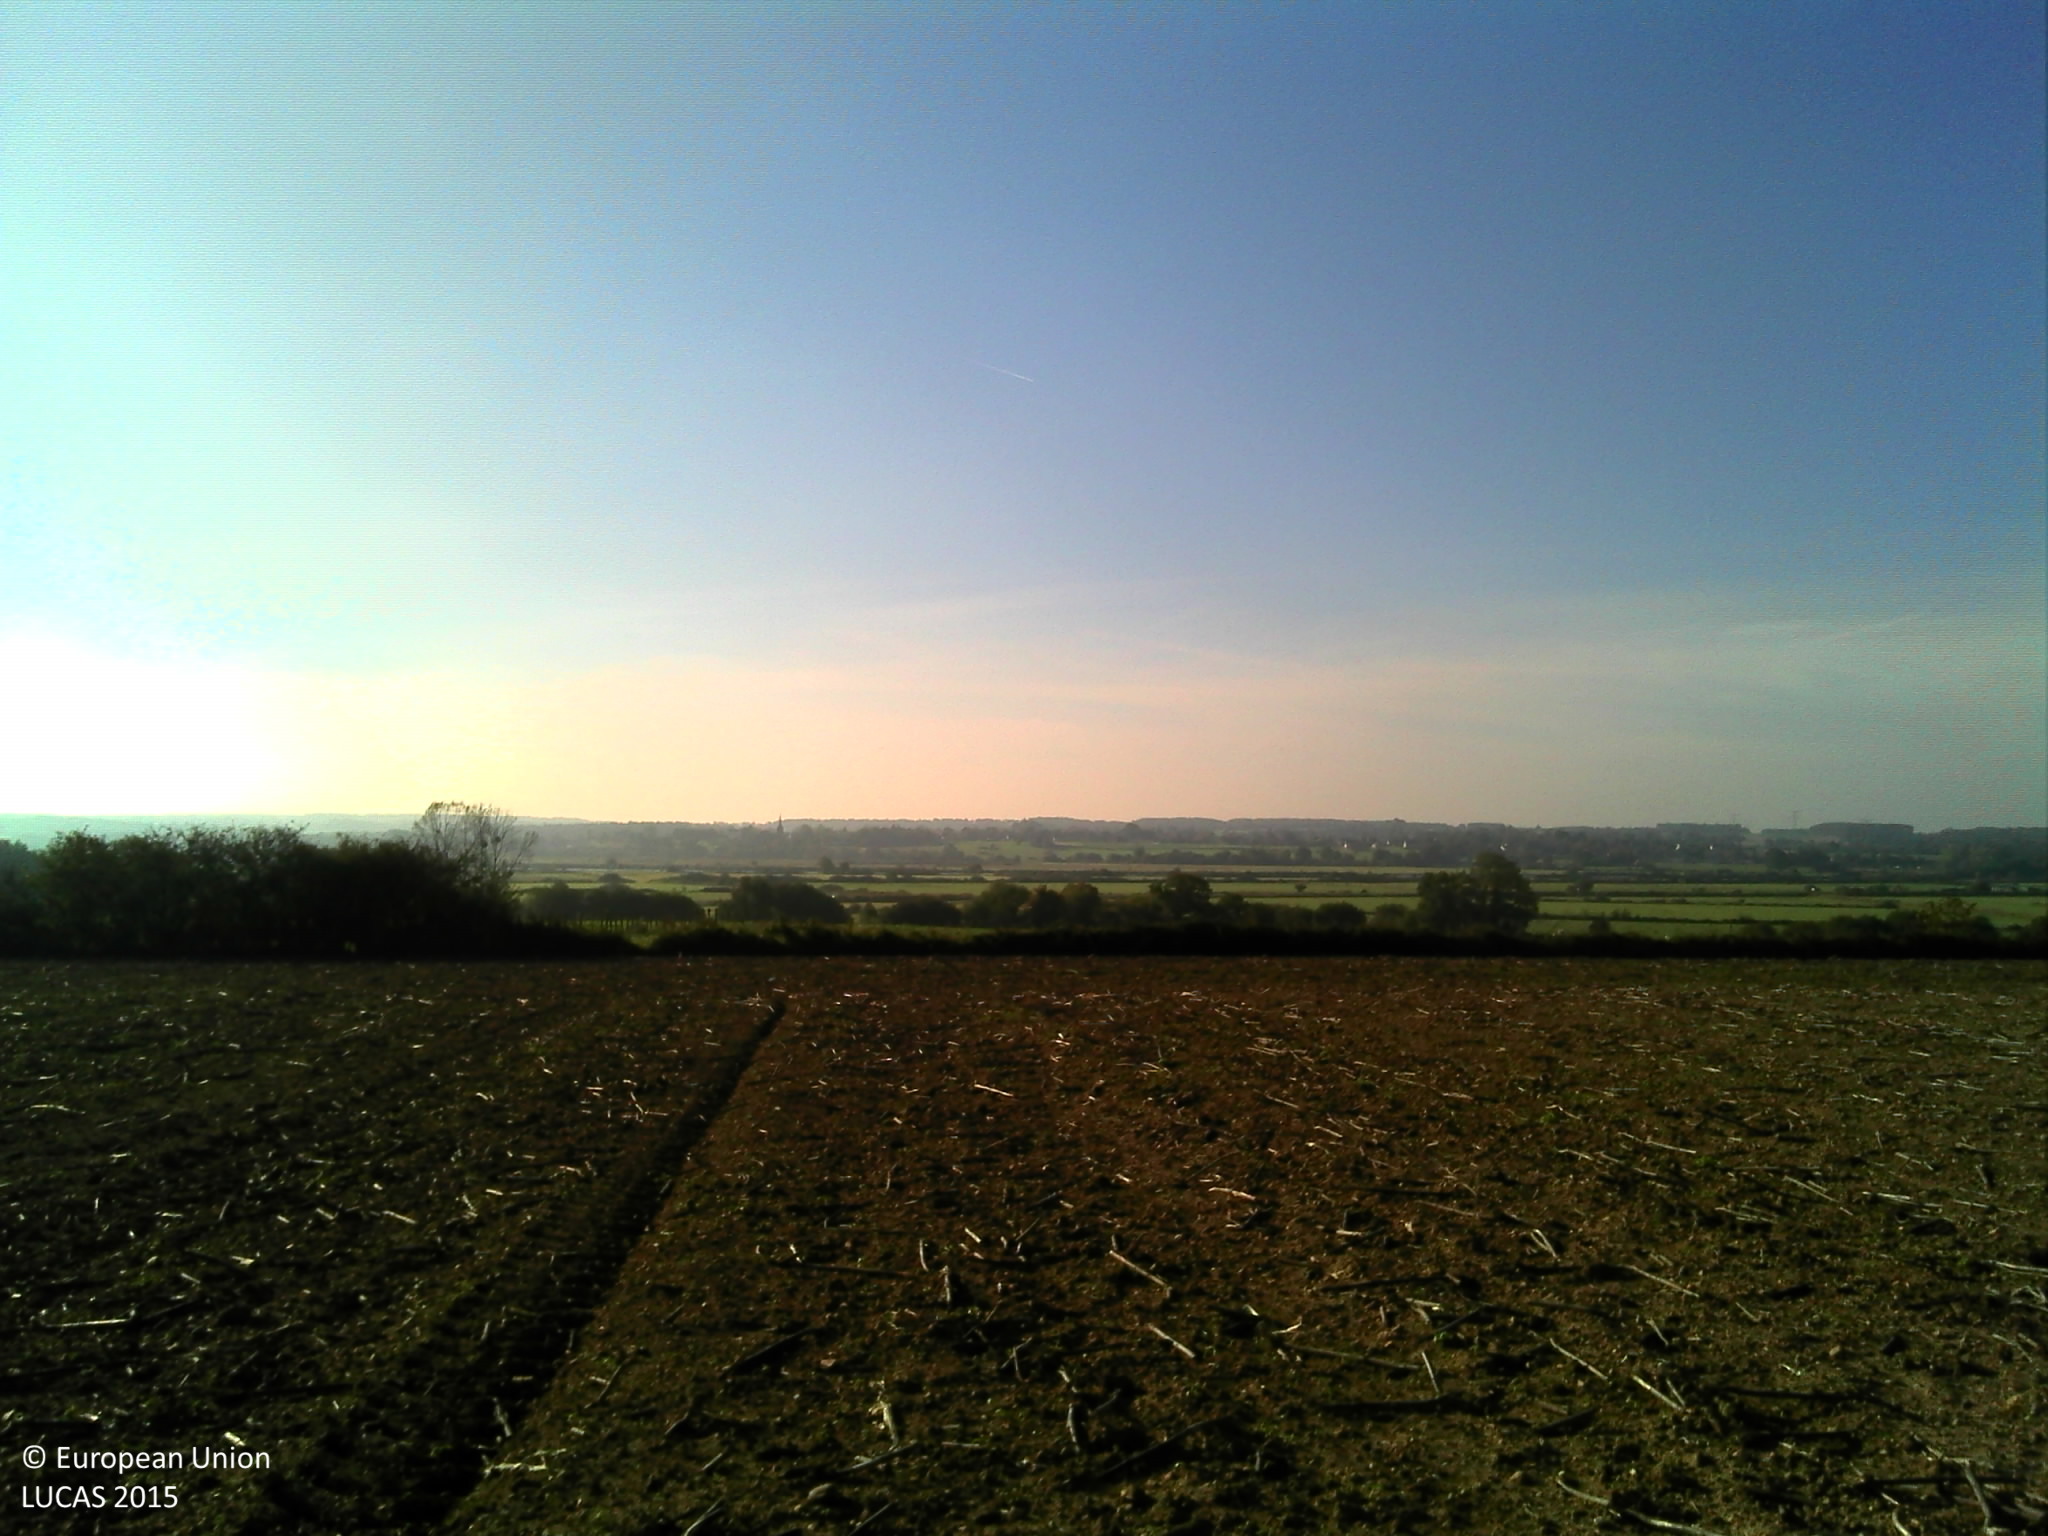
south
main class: Cropland
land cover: Sunflower
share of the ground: < 10 %
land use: Agriculture (excluding fallow land and kitchen gardens)
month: October
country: FR
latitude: 47.5892
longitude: -2.1127
